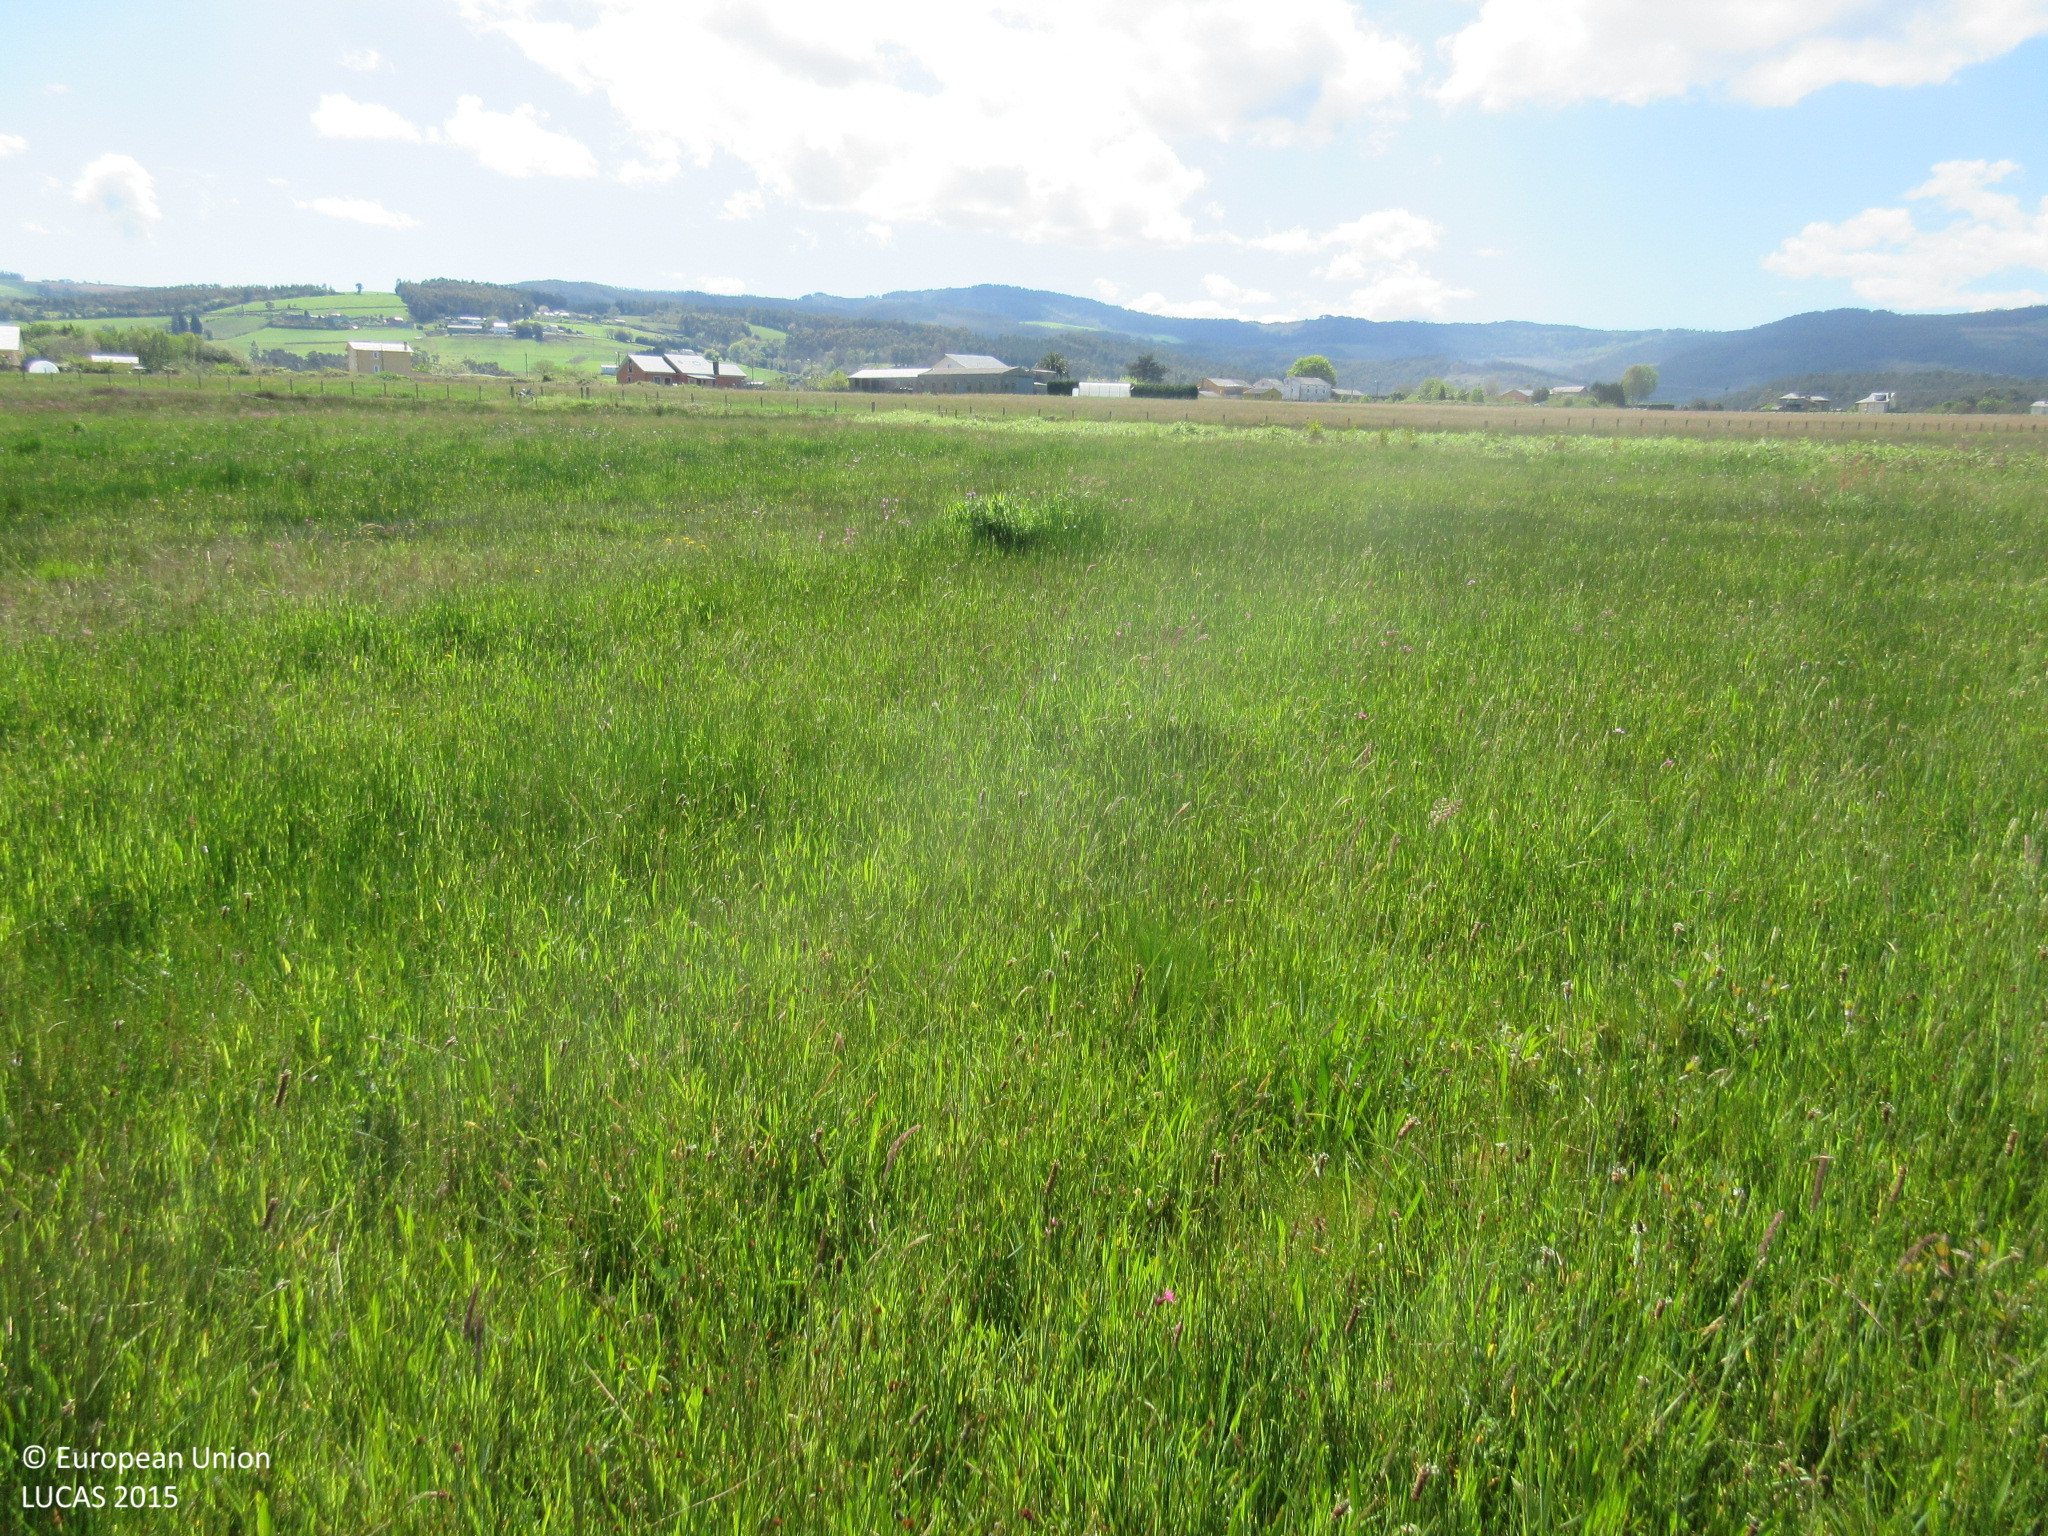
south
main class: Grassland
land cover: Grassland without tree/shrub cover
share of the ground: > 75 %
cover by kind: herbaceous plants 100 %
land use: Agriculture (excluding fallow land and kitchen gardens)
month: April
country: ES
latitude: 43.5272
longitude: -6.9817
